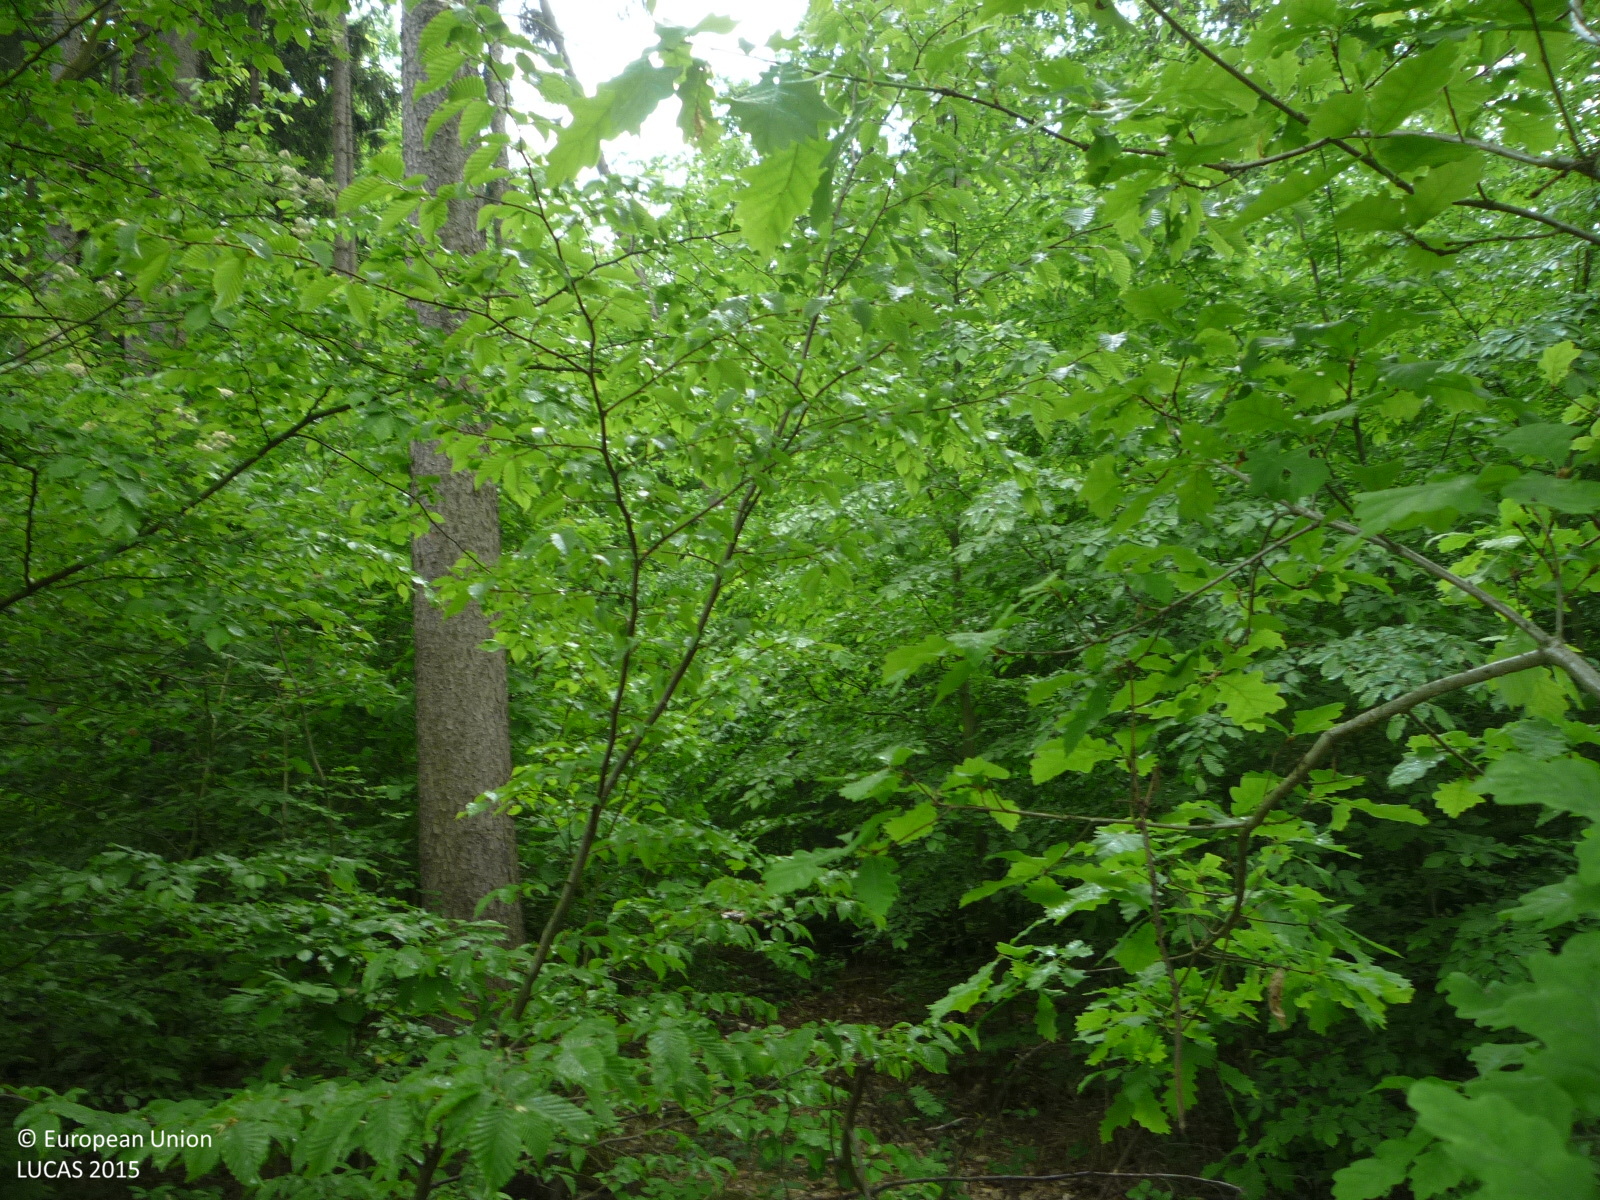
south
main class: Woodland
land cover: Spruce dominated mixed woodland
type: hemiboreal forest and nemoral coniferous forest and mixed broadleaved-coniferous forest
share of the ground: > 75 %
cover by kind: coniferous forest trees 60 %, broadleaved forest trees 30 %, herbaceous plants 5 %, unconsolidated bare surface 5 %
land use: Forestry
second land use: Sport
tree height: > 5 m
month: May
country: CZ
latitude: 50.0241
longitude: 14.4822
